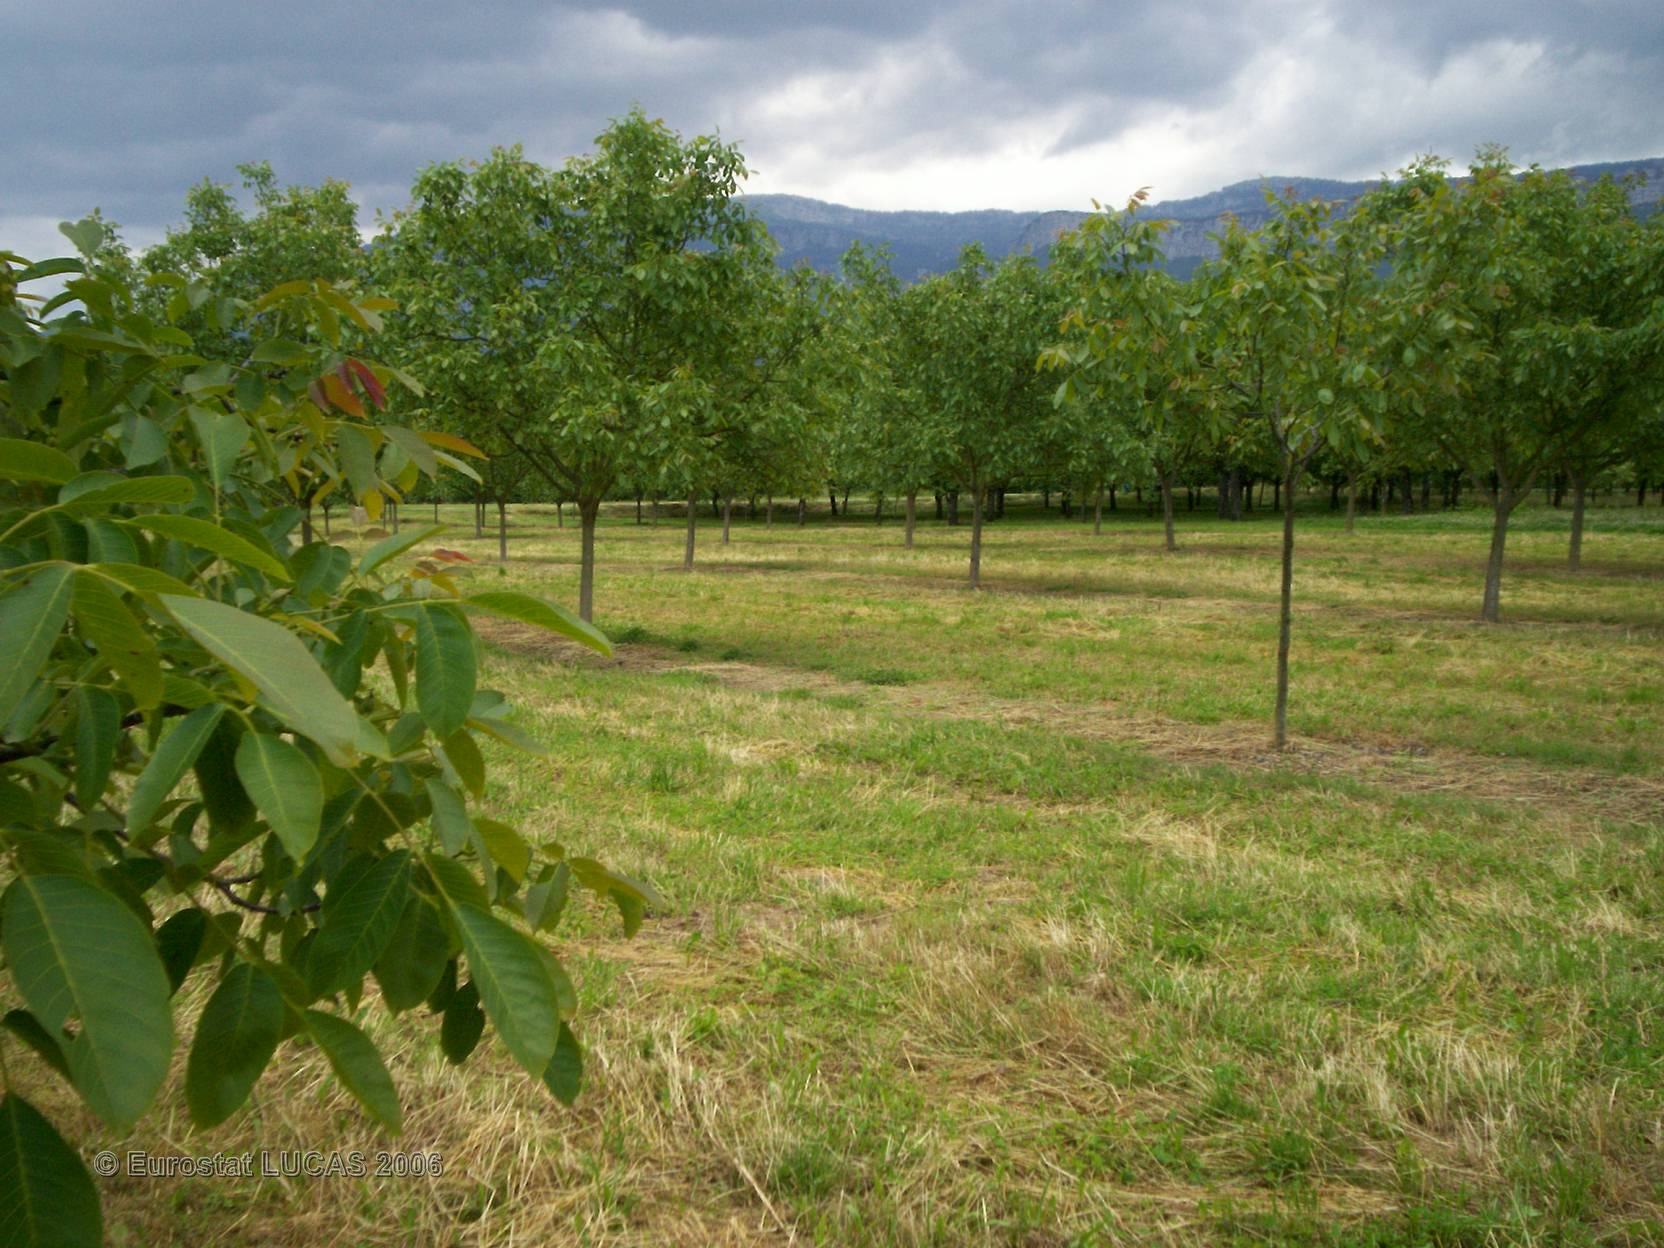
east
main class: Cropland
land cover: Nuts trees
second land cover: Grassland with sparse tree/shrub cover
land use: Agriculture (excluding fallow land and kitchen gardens)
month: June
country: FR
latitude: 45.2071
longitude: 5.4346
